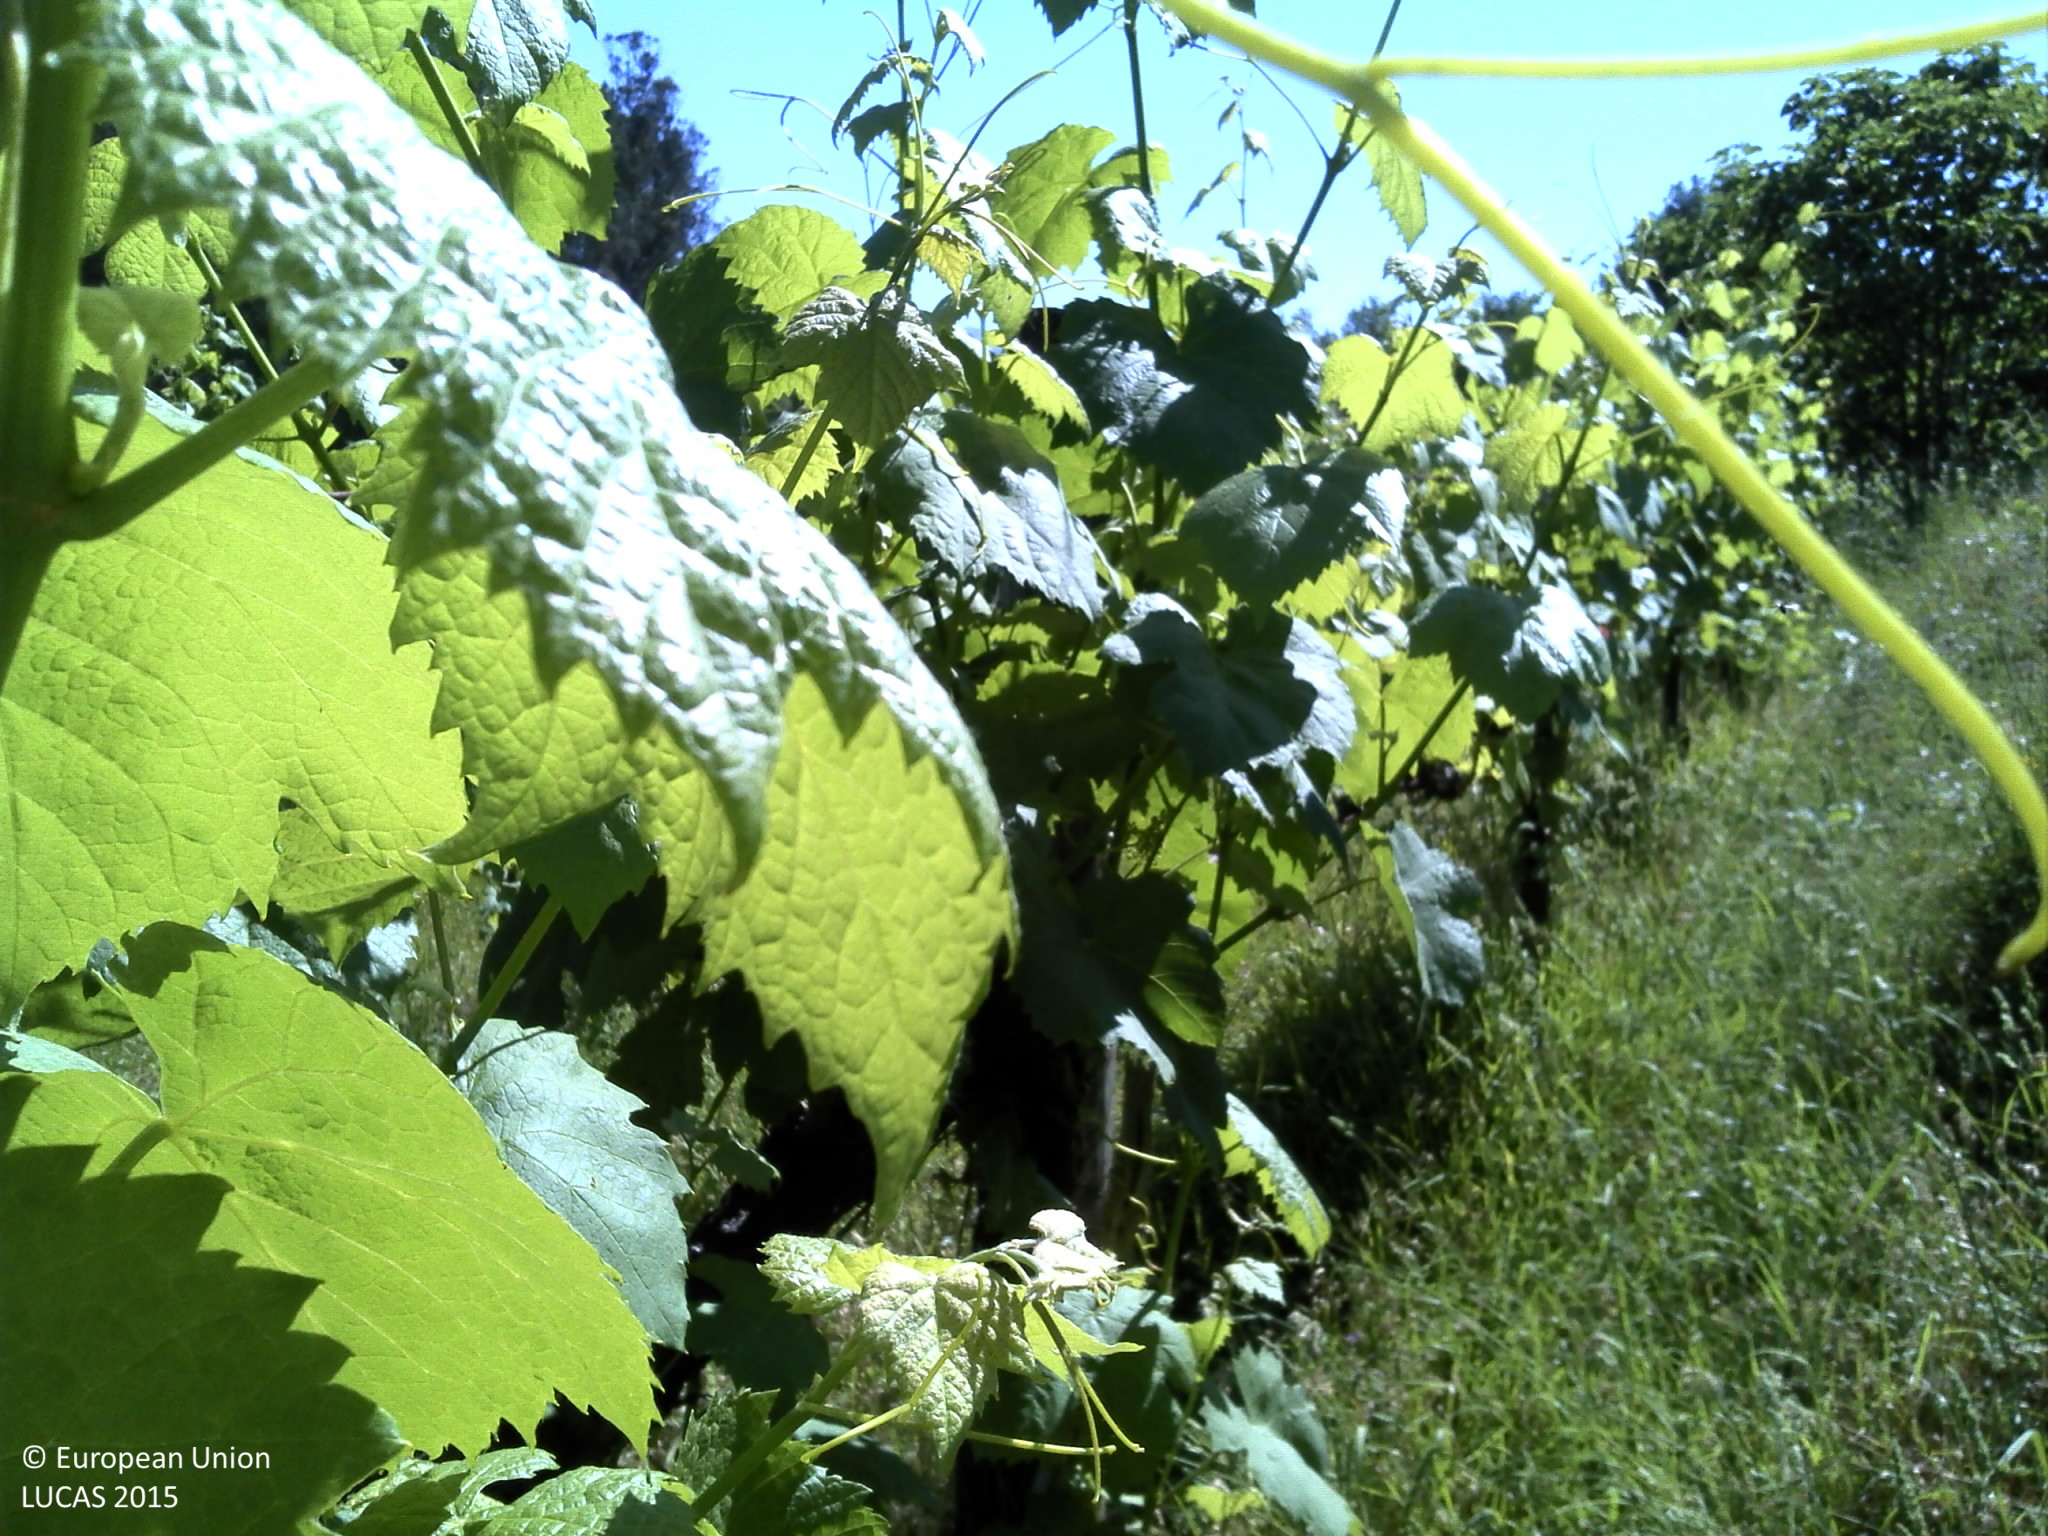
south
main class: Cropland
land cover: Vineyards
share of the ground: 10 - 25 %
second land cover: Grassland without tree/shrub cover
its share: 50 - 75 %
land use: Agriculture (excluding fallow land and kitchen gardens)
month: June
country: PT
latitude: 41.8419
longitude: -8.3783
